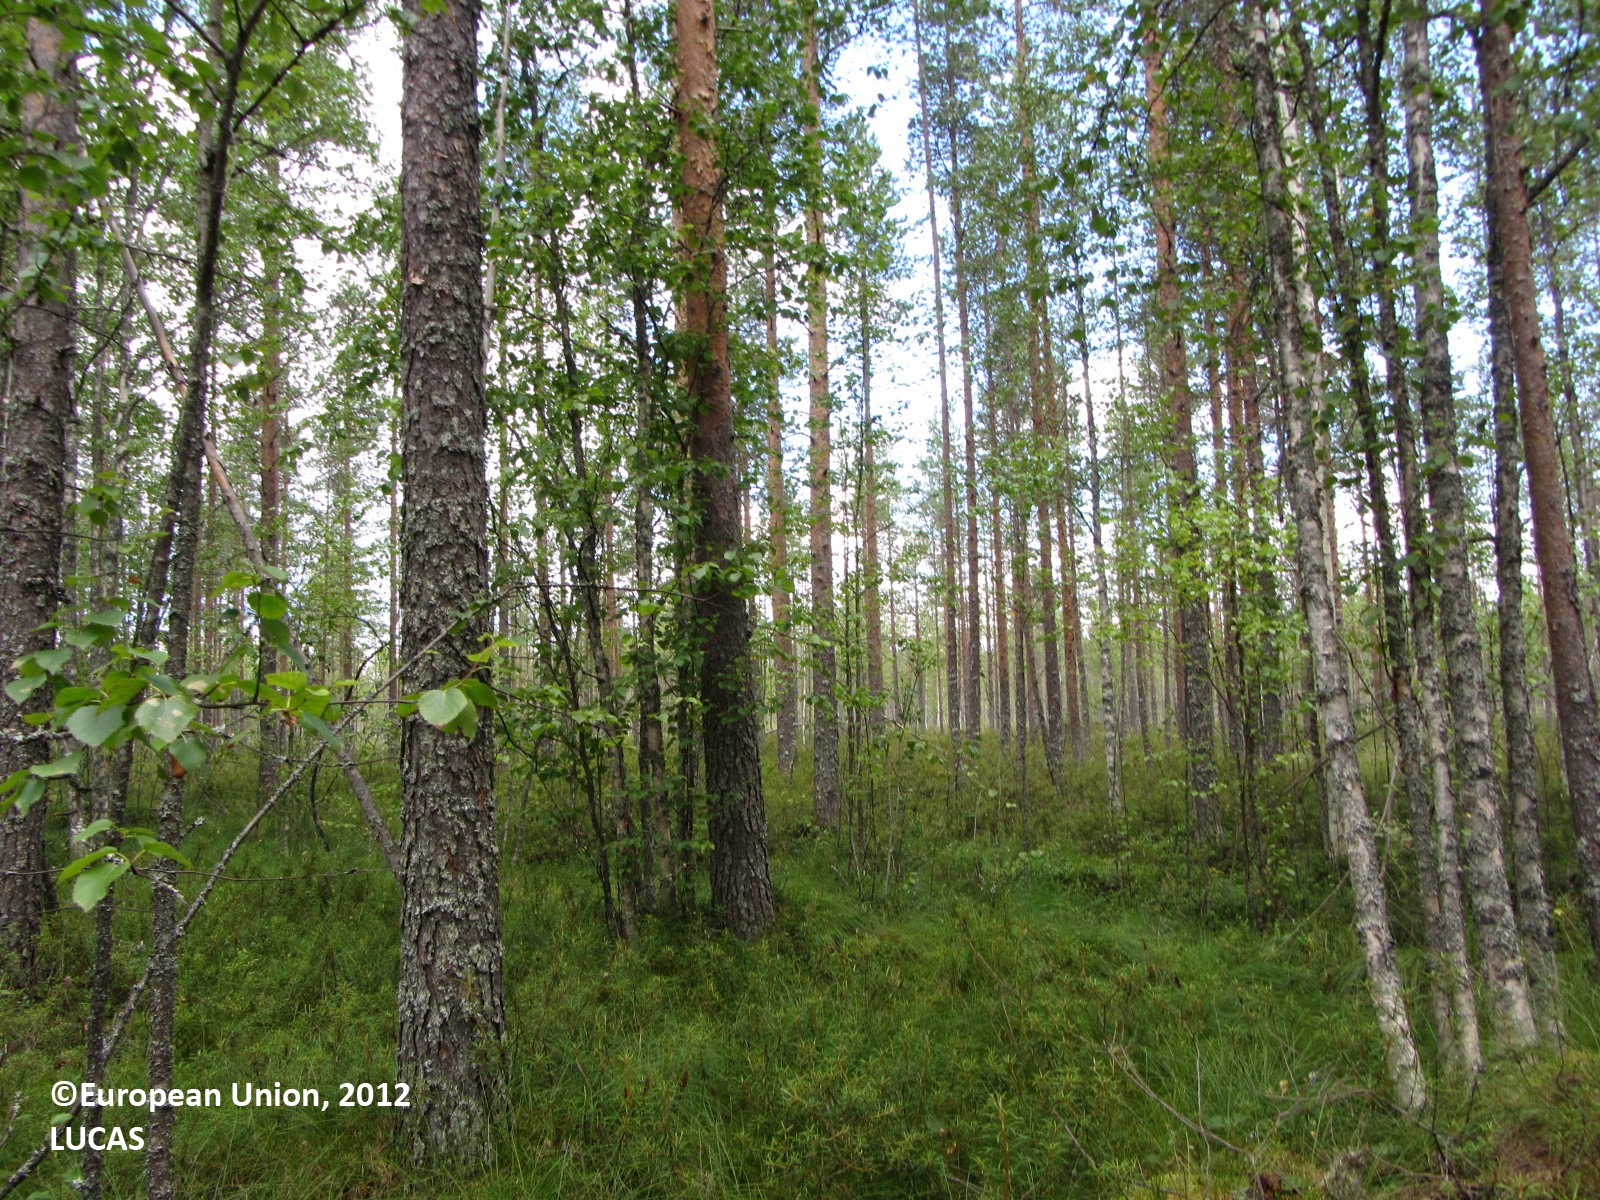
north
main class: Woodland
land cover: Pine dominated mixed woodland
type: mire and swamp forests
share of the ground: > 75 %
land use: Forestry
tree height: > 5 m
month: August
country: FI
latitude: 63.3225
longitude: 25.2503
